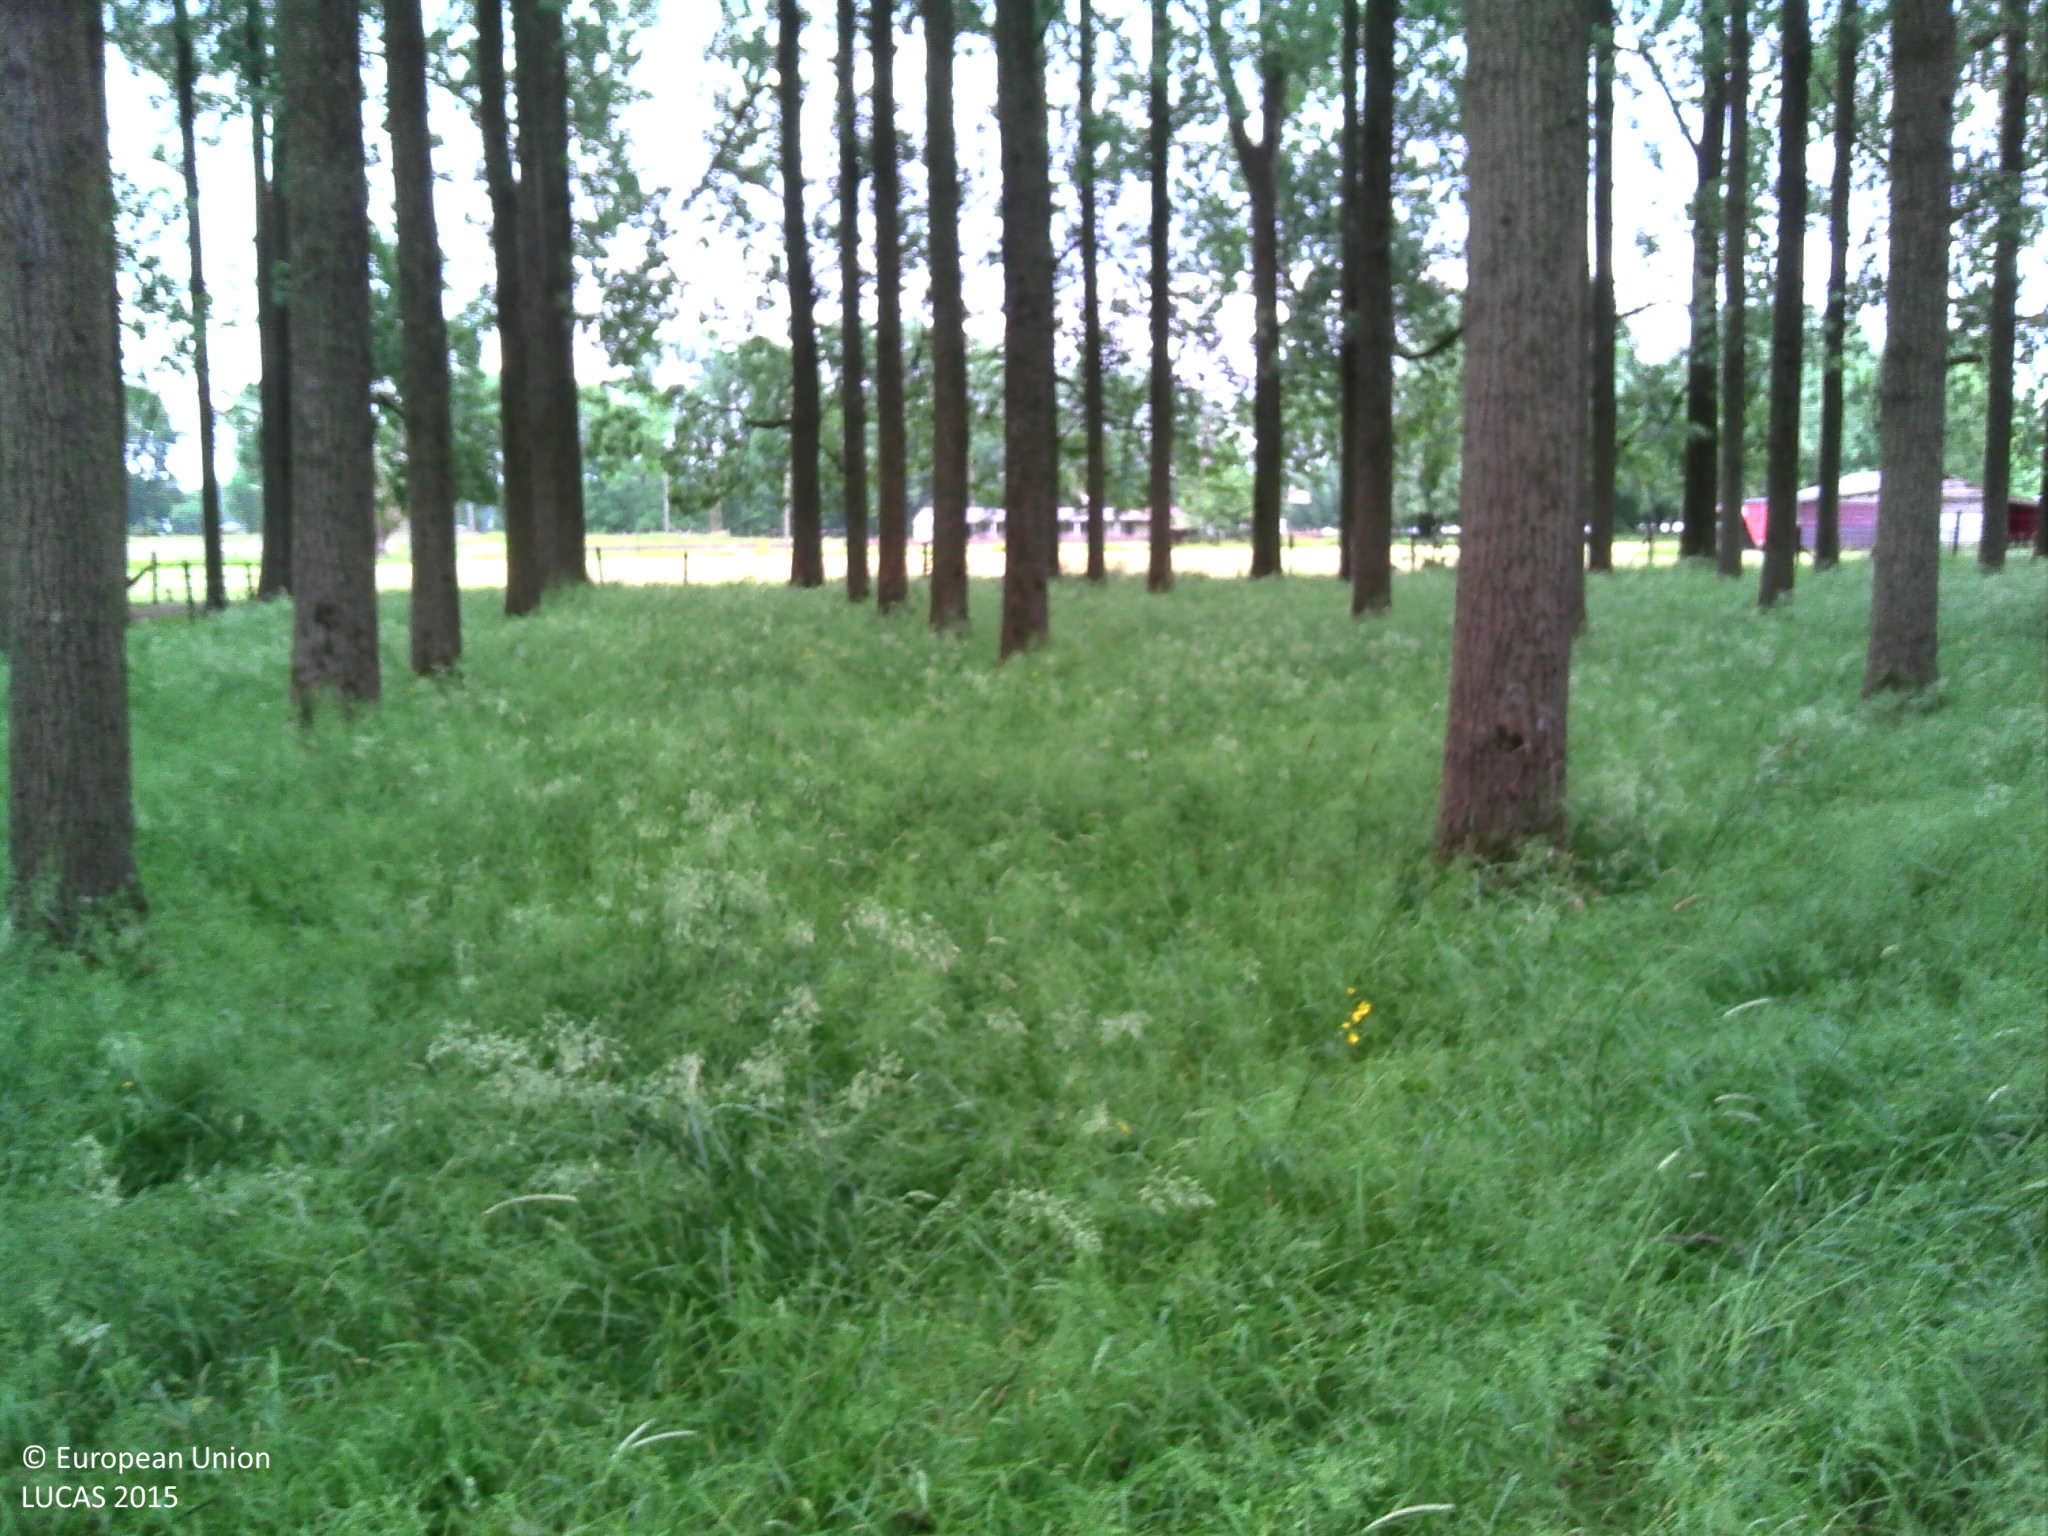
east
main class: Woodland
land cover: Broadleaved woodland
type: exotic forest
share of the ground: > 75 %
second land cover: Grassland without tree/shrub cover
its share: > 75 %
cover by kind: broadleaved forest trees 75 %, herbaceous plants 25 %
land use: Forestry
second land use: Agriculture (excluding fallow land and kitchen gardens)
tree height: > 5 m
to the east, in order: Broadleaved woodland; Grassland without tree/shrub cover; Fences; Grassland without tree/shrub cover; Fences; Lines of trees; Fences; Grassland without tree/shrub cover; Electric lines; Grass margins; Ditches and canals; Maize; Grass margins; Tracks; Fences; Grassland without tree/shrub cover
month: June
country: BE
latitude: 50.9817
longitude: 3.9974
